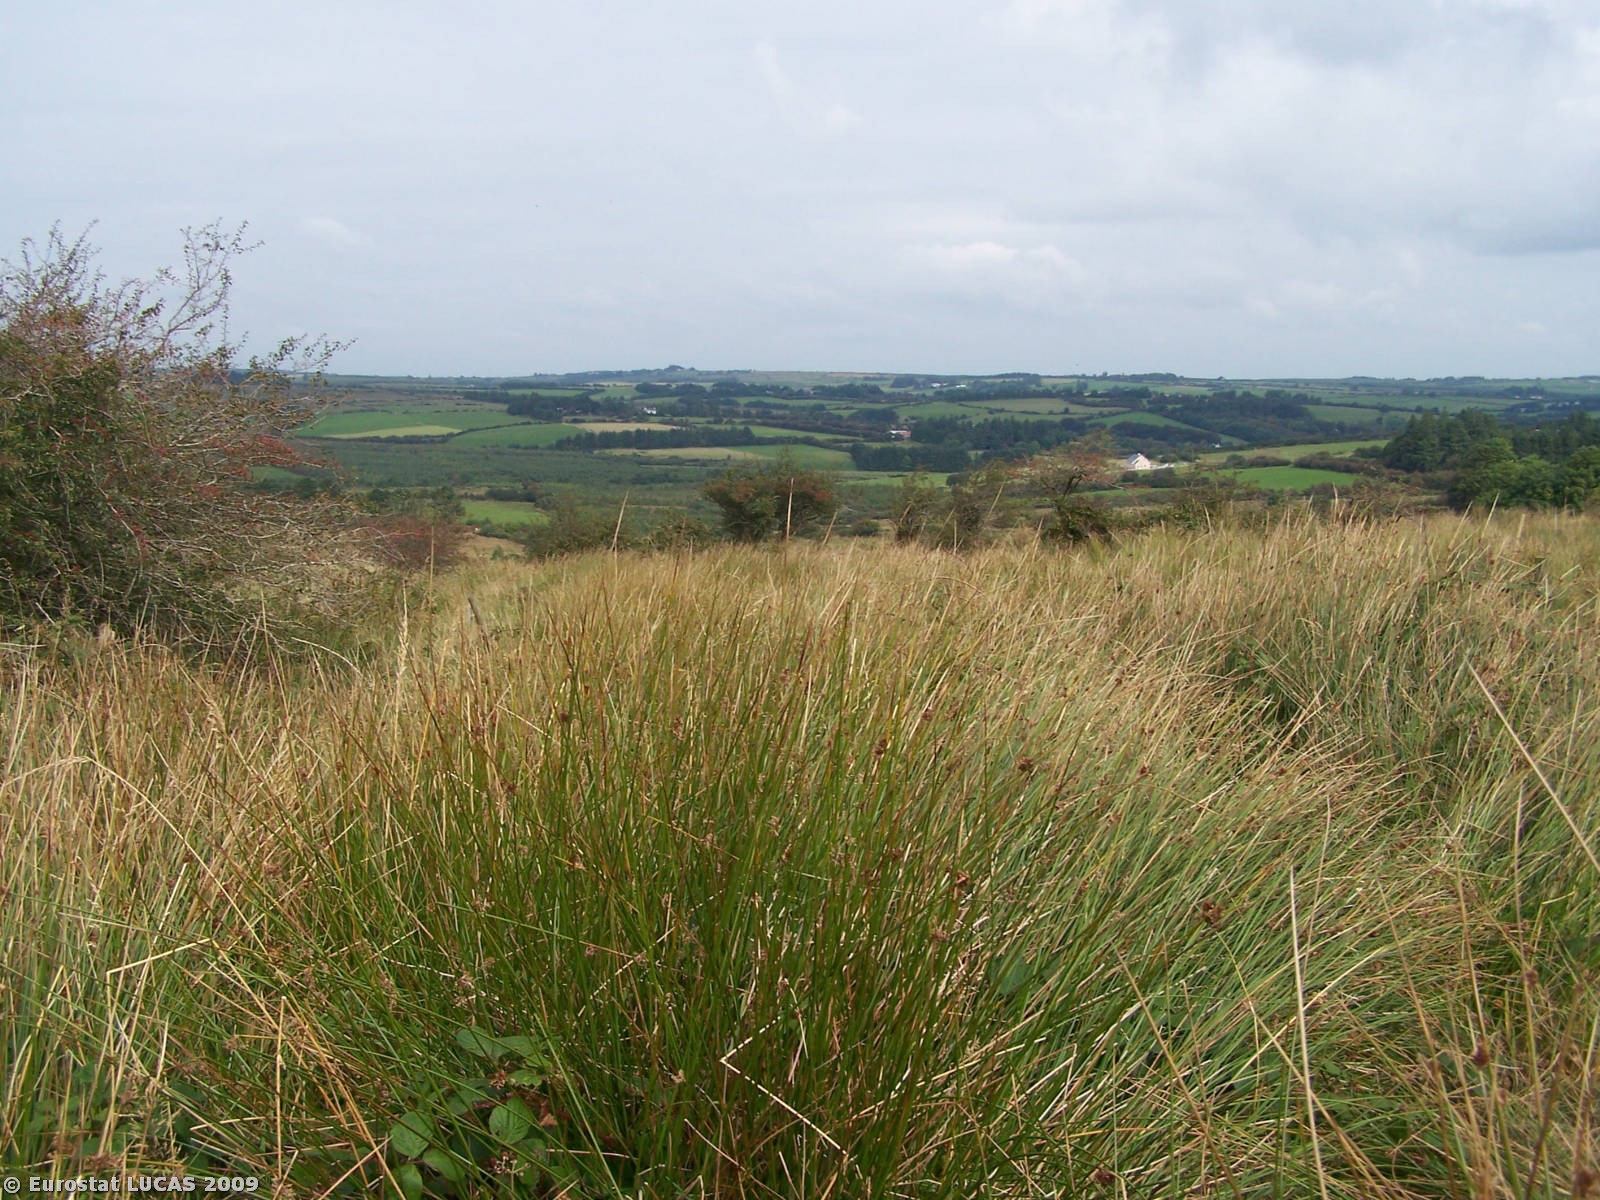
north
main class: Grassland
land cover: Grassland without tree/shrub cover
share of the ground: > 75 %
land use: Agriculture (excluding fallow land and kitchen gardens)
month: September
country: IE
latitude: 52.2801
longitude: -9.0196
